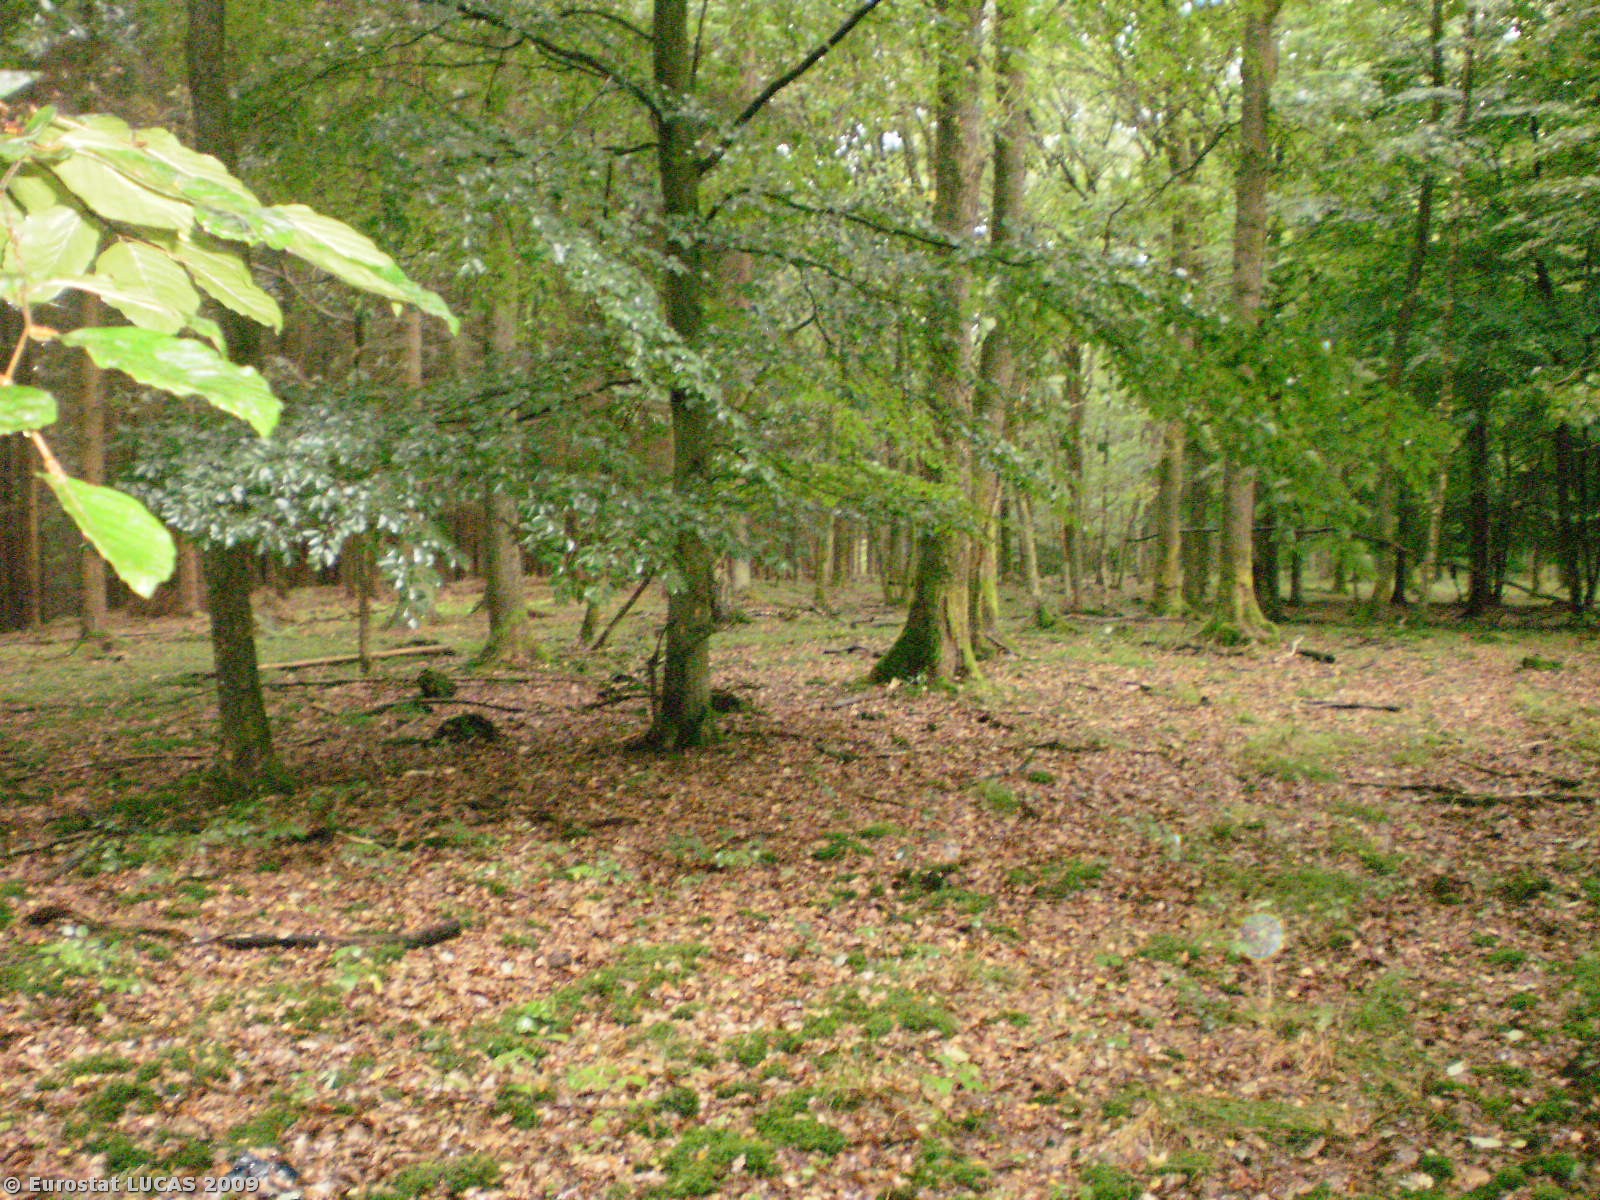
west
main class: Woodland
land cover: Broadleaved woodland
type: beech forest
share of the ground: > 75 %
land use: Nature reserves
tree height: > 5 m
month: September
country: BE
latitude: 50.3335
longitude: 5.6011
